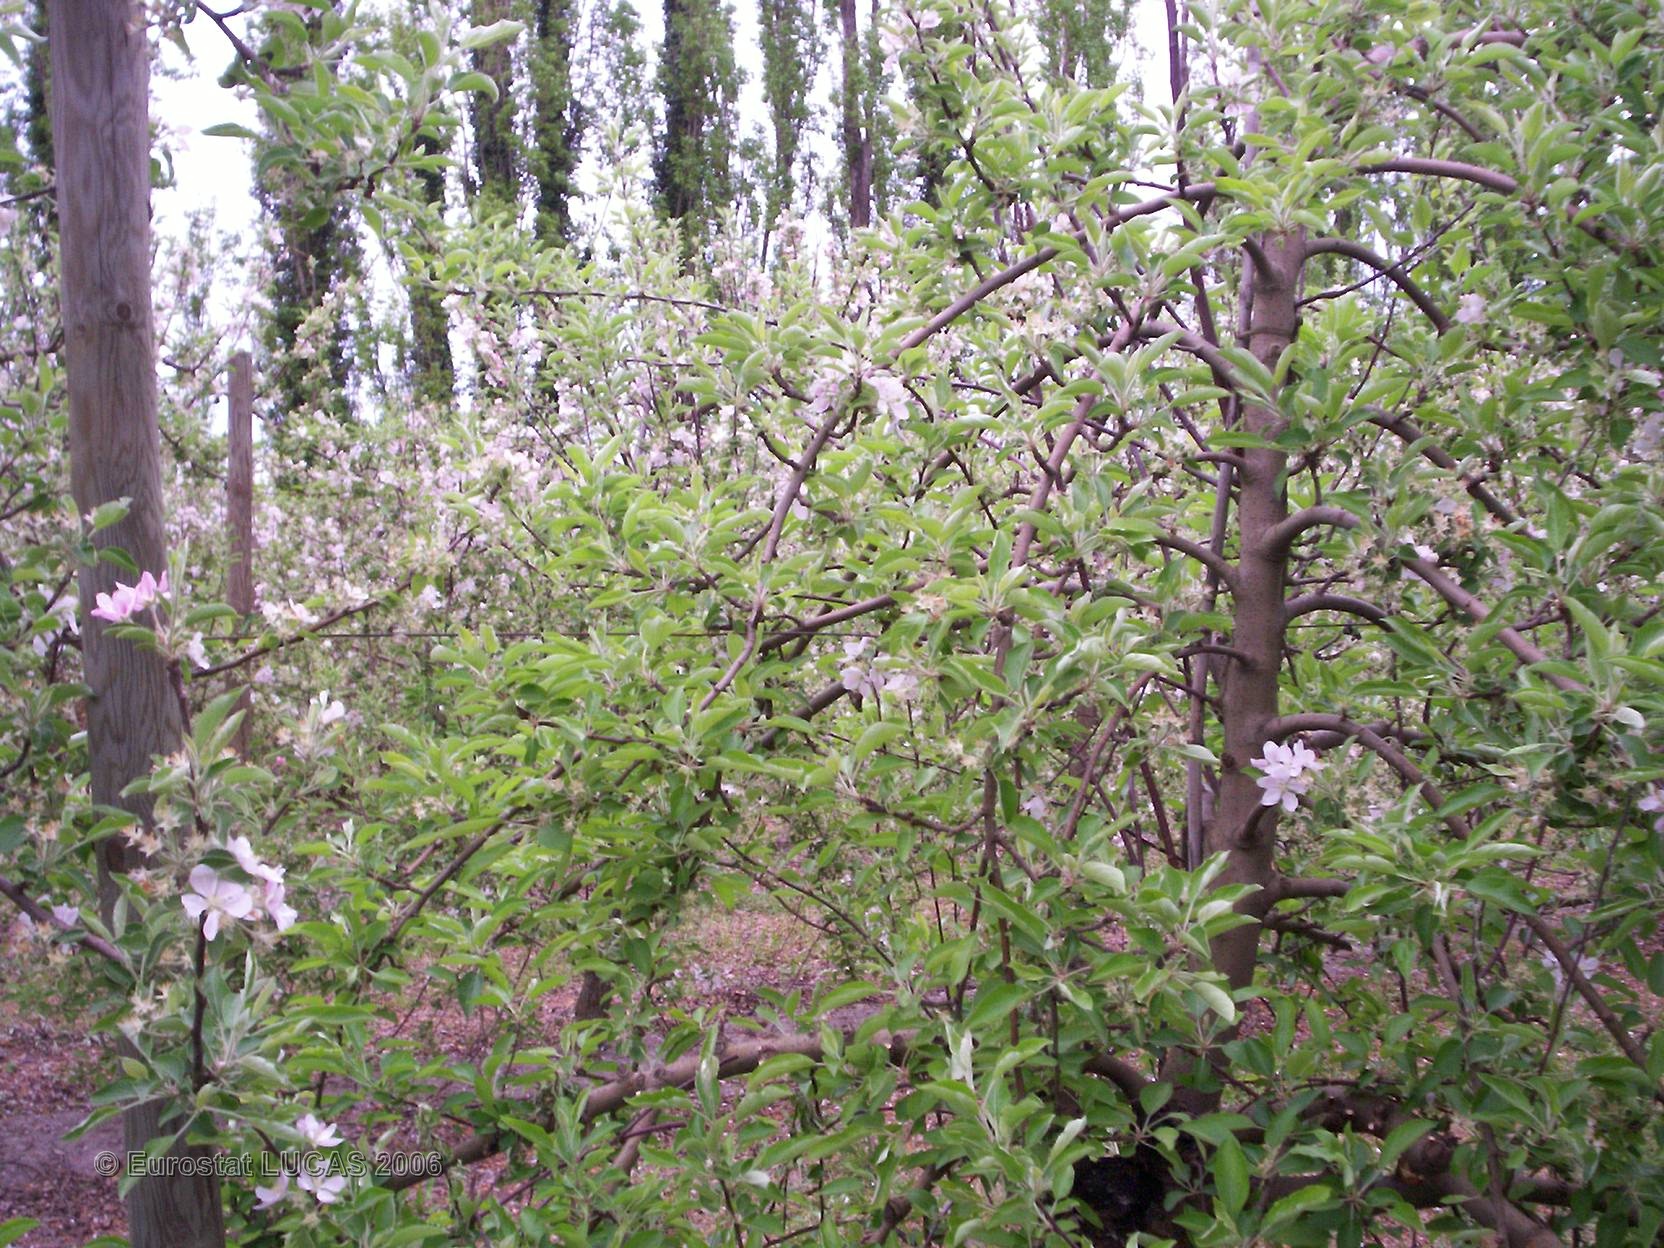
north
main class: Cropland
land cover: Apple fruit
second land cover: Grassland with sparse tree/shrub cover
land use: Agriculture (excluding fallow land and kitchen gardens)
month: April
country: FR
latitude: 43.8287
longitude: 4.9230
